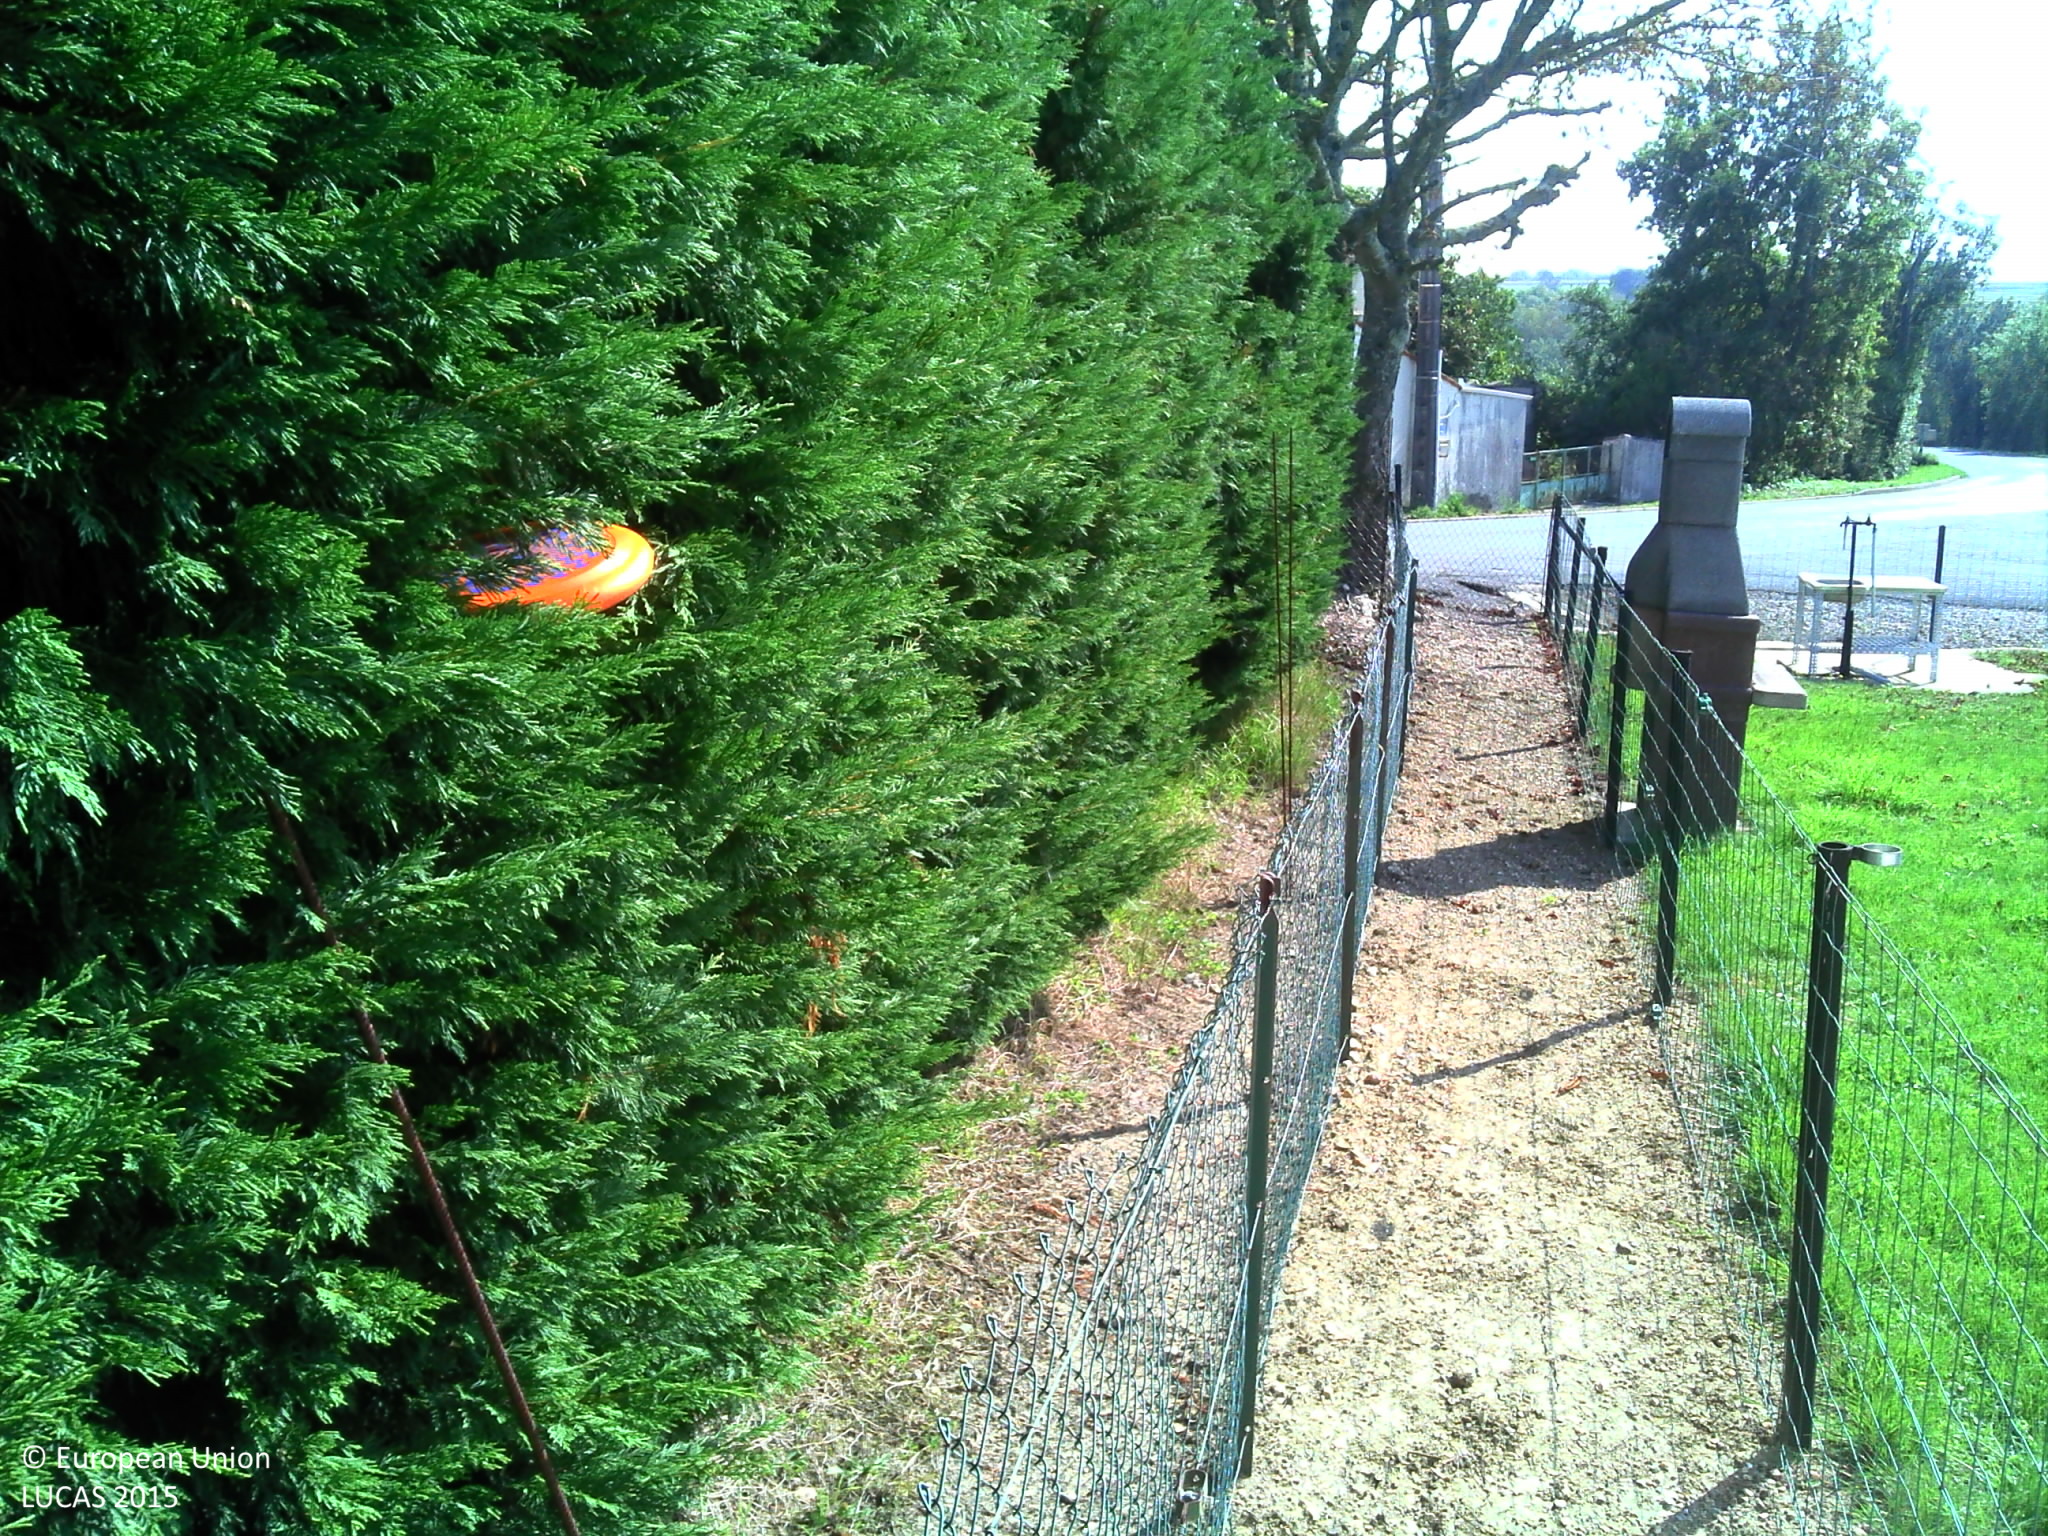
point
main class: Grassland
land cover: Grassland without tree/shrub cover
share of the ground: > 75 %
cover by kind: herbaceous plants 100 %
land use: Residential
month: October
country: FR
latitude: 46.4445
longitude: -1.2684
